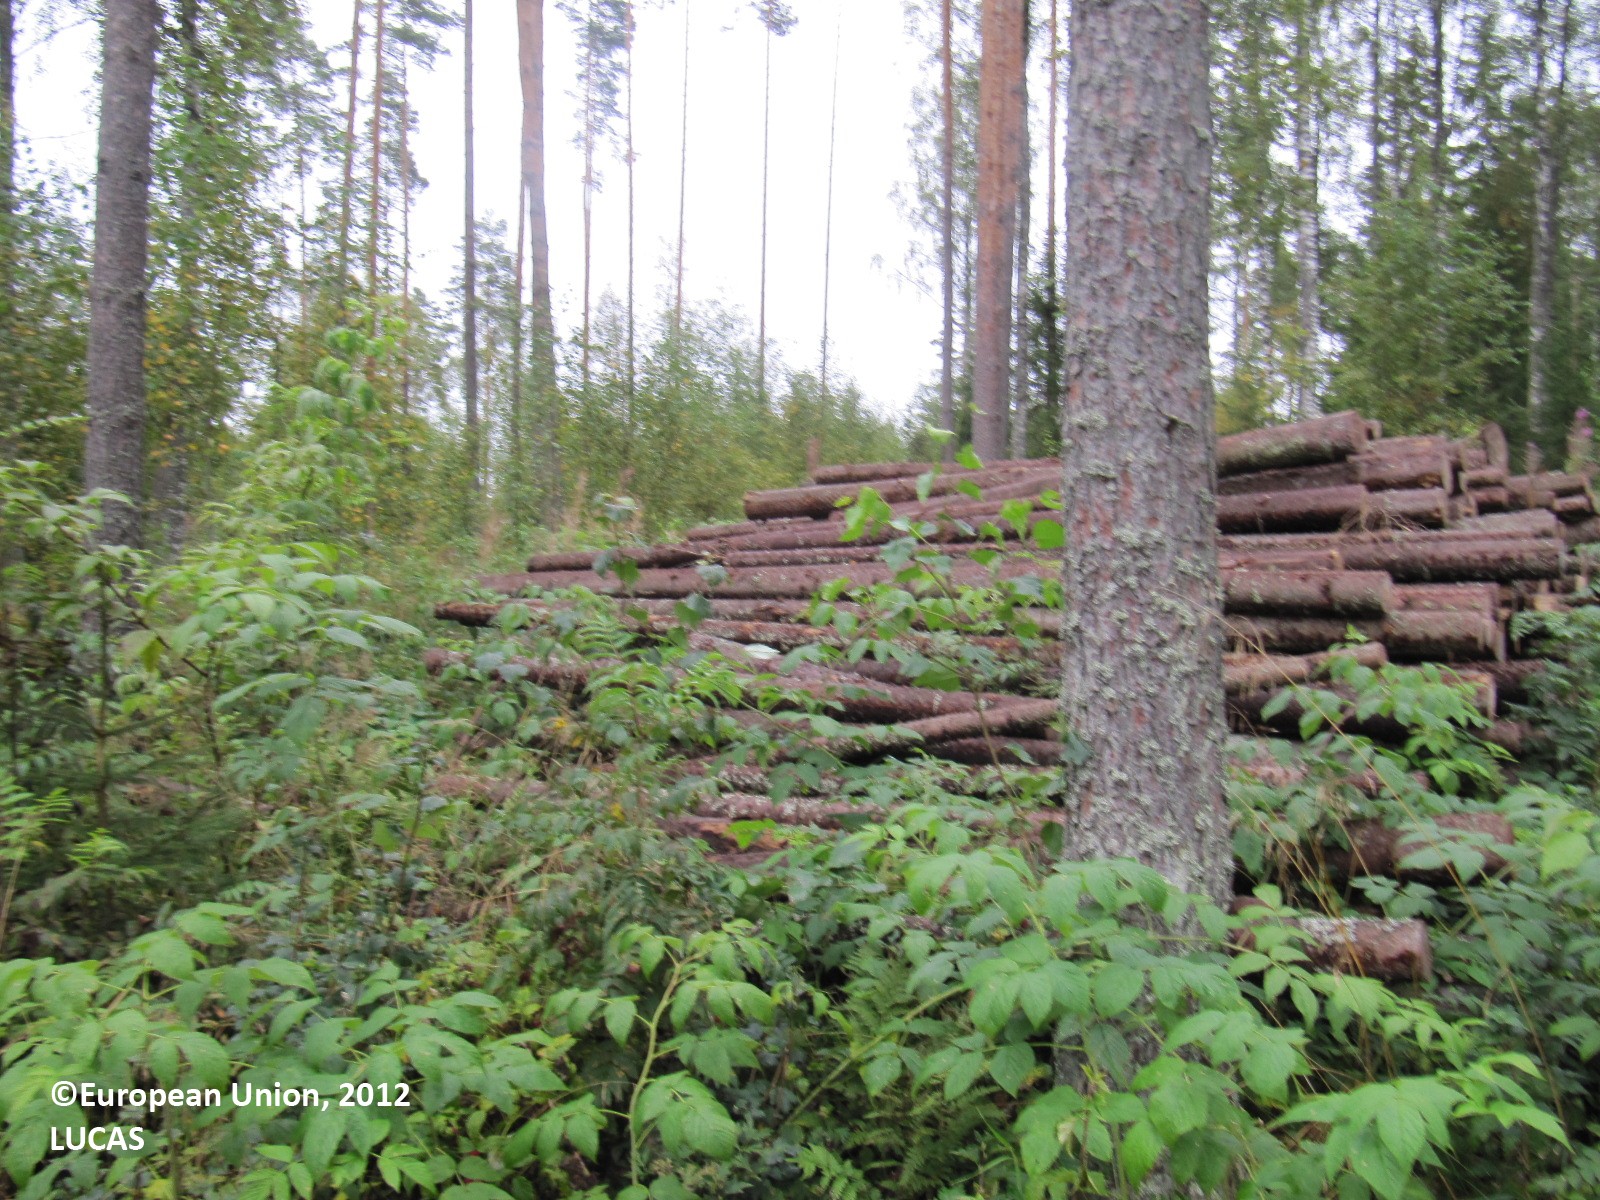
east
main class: Woodland
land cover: Pine dominated mixed woodland
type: boreal forest
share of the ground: 25 - 50 %
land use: Forestry
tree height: > 5 m
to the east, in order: Pine dominated mixed woodland; Other mixed woodland; Arable land (only in case pi); Tracks; Arable land (only in case pi)
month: August
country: FI
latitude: 61.0393
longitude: 23.3923
